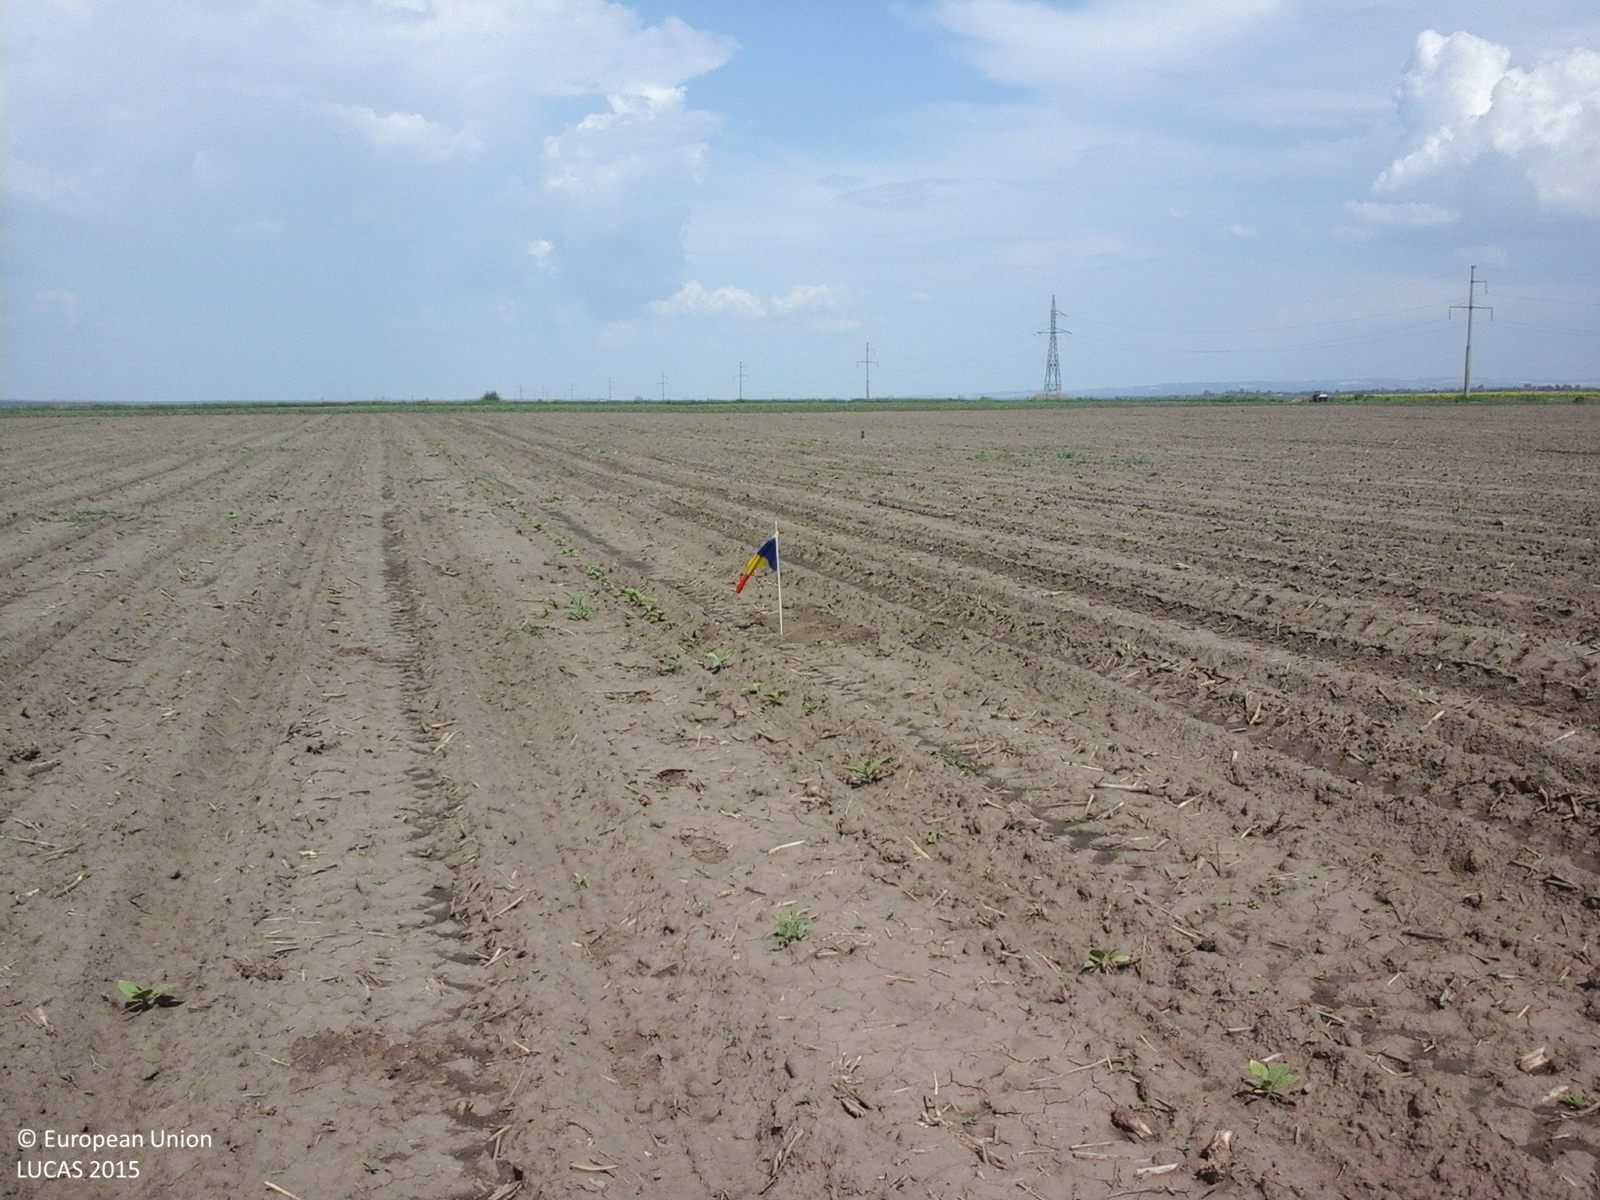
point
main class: Cropland
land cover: Tobacco
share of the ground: < 10 %
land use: Agriculture (excluding fallow land and kitchen gardens)
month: July
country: RO
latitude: 43.6837
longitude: 25.4271
